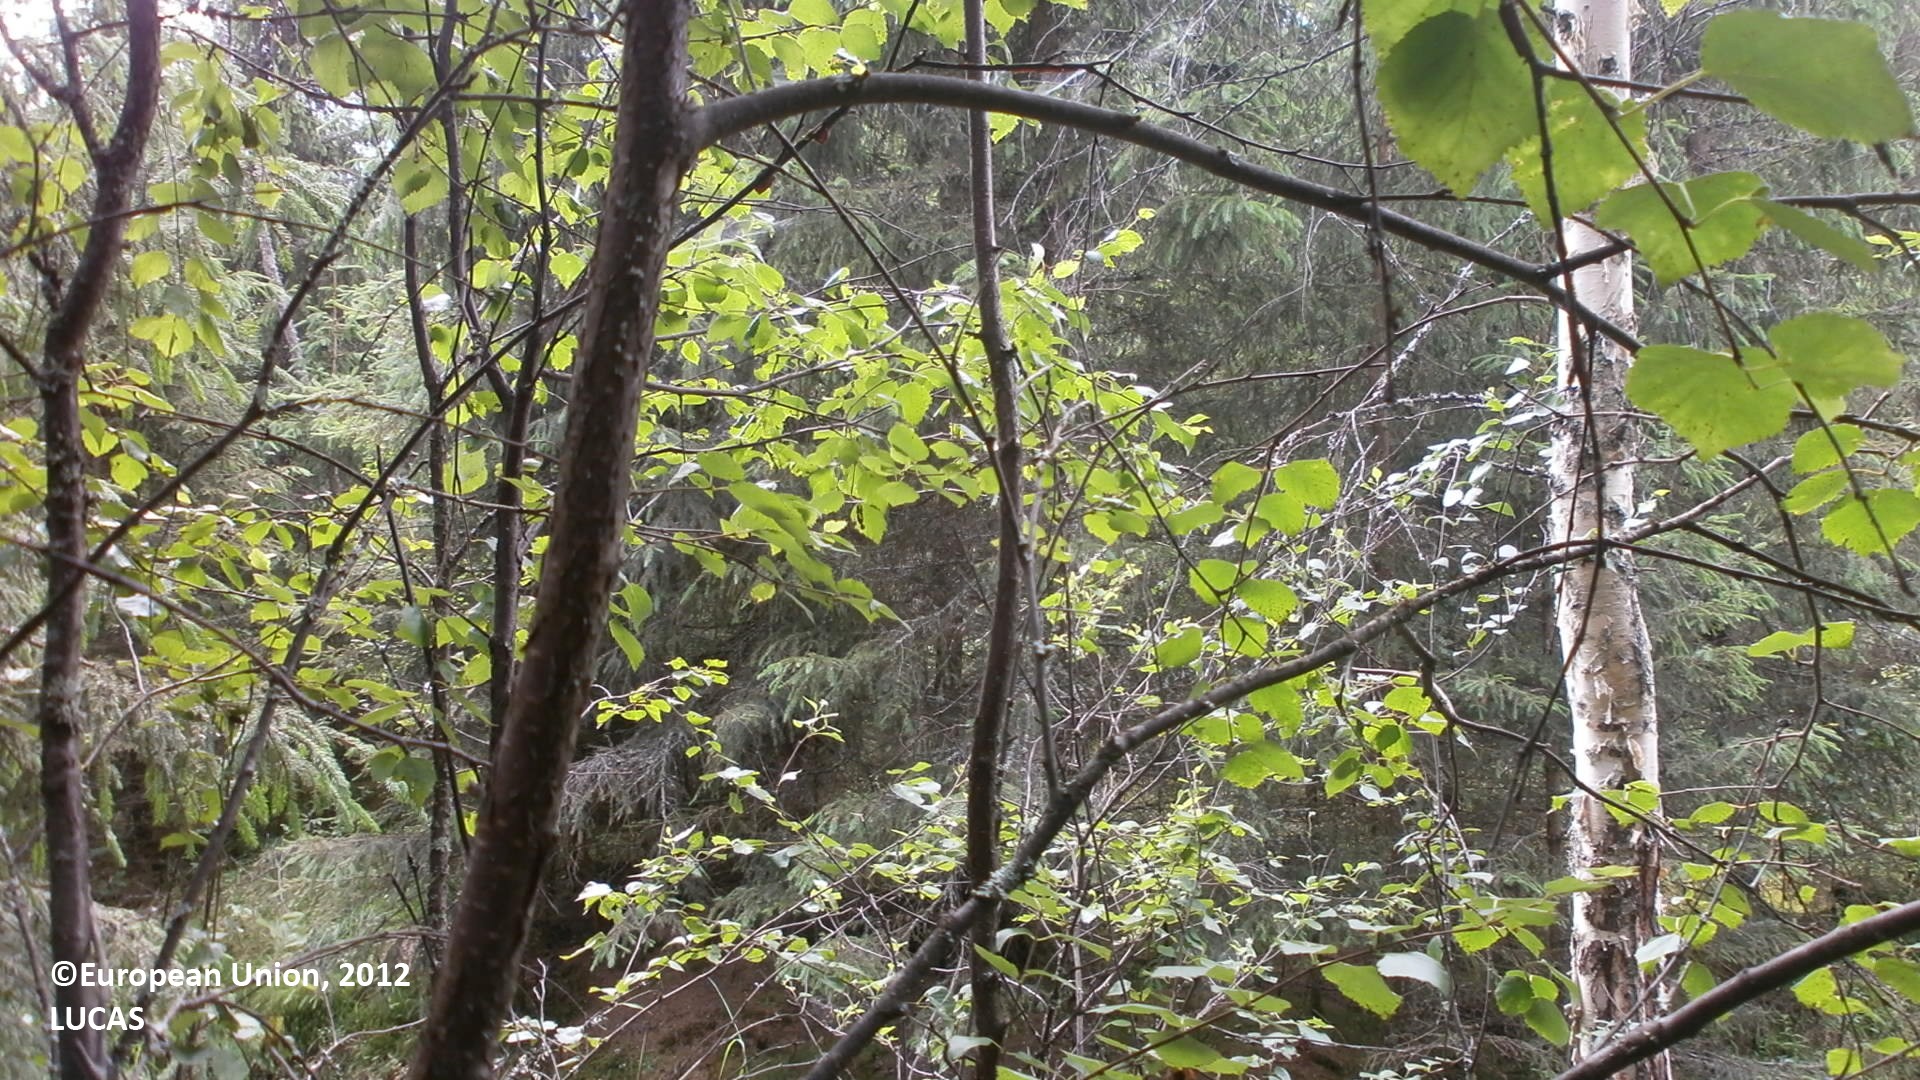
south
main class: Woodland
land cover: Spruce dominated coniferous woodland
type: boreal forest
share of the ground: > 75 %
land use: Forestry
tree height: > 5 m
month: July
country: FI
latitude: 64.2342
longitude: 24.4001
